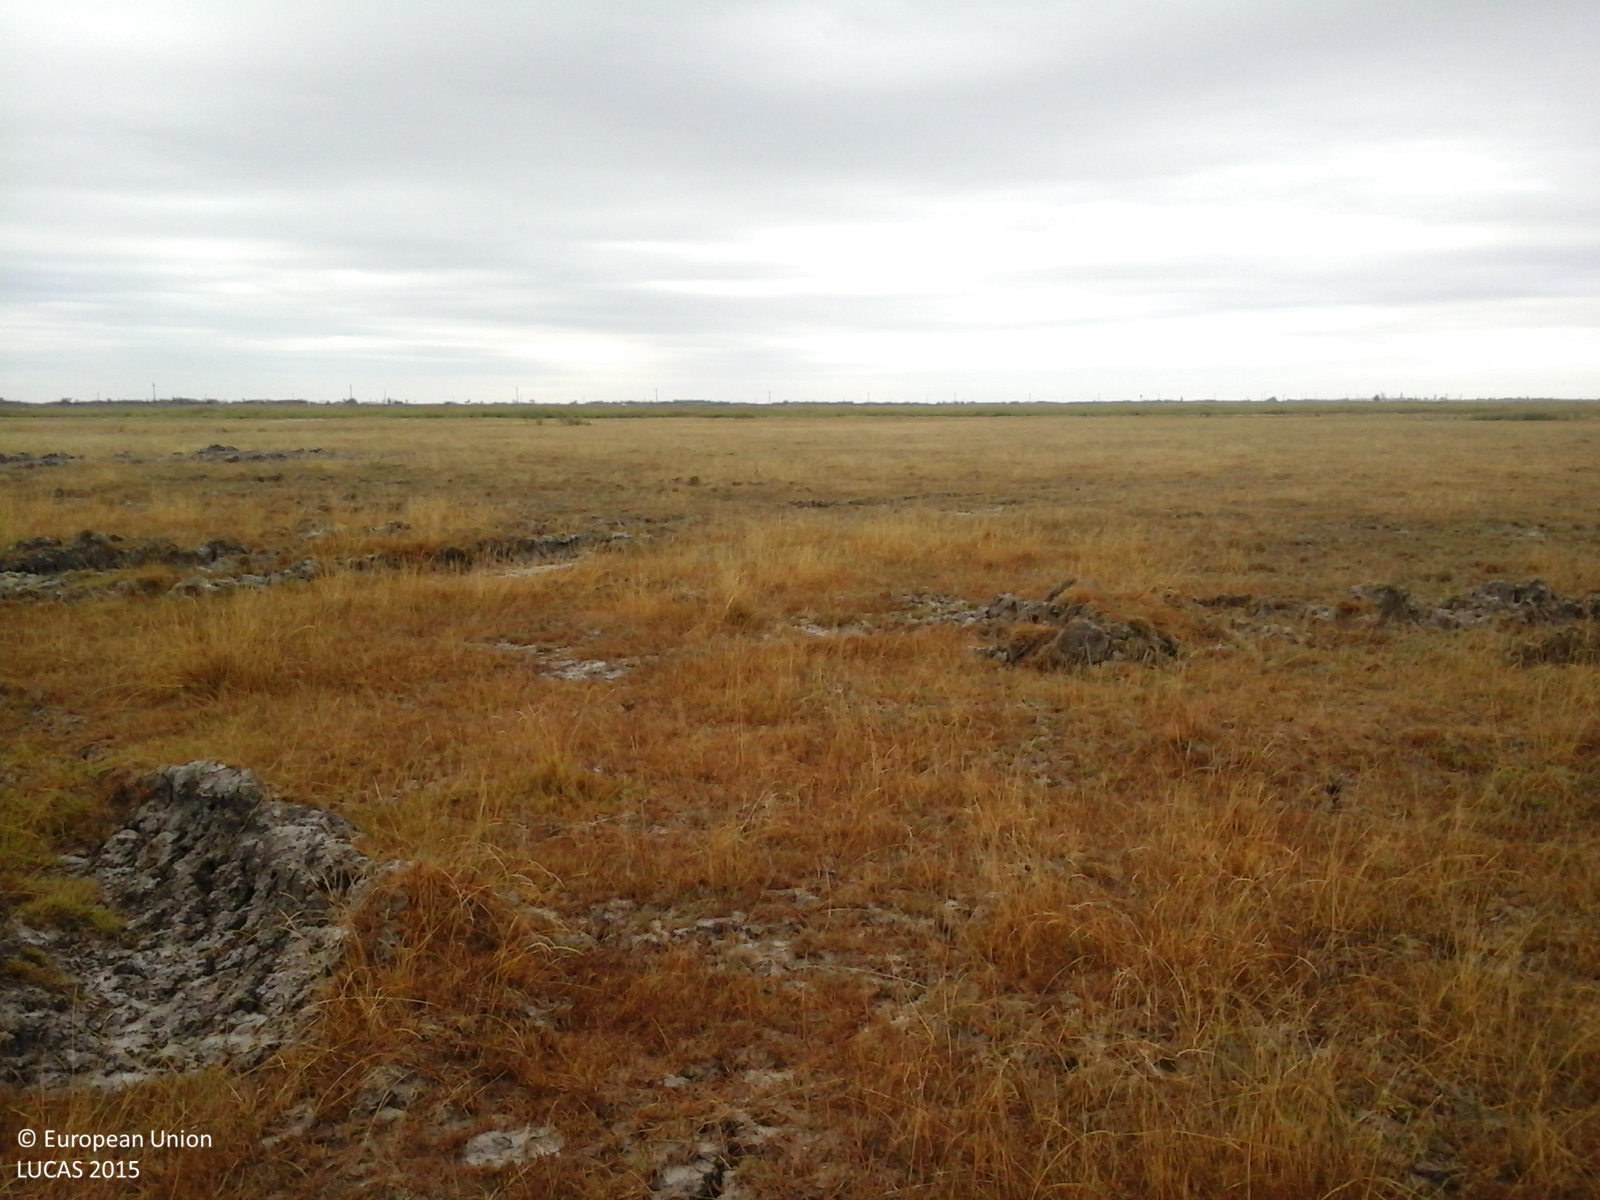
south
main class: Grassland
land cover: Grassland without tree/shrub cover
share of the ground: > 75 %
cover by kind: herbaceous plants 100 %
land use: Agriculture (excluding fallow land and kitchen gardens)
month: August
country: RO
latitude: 45.5811
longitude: 21.0105
